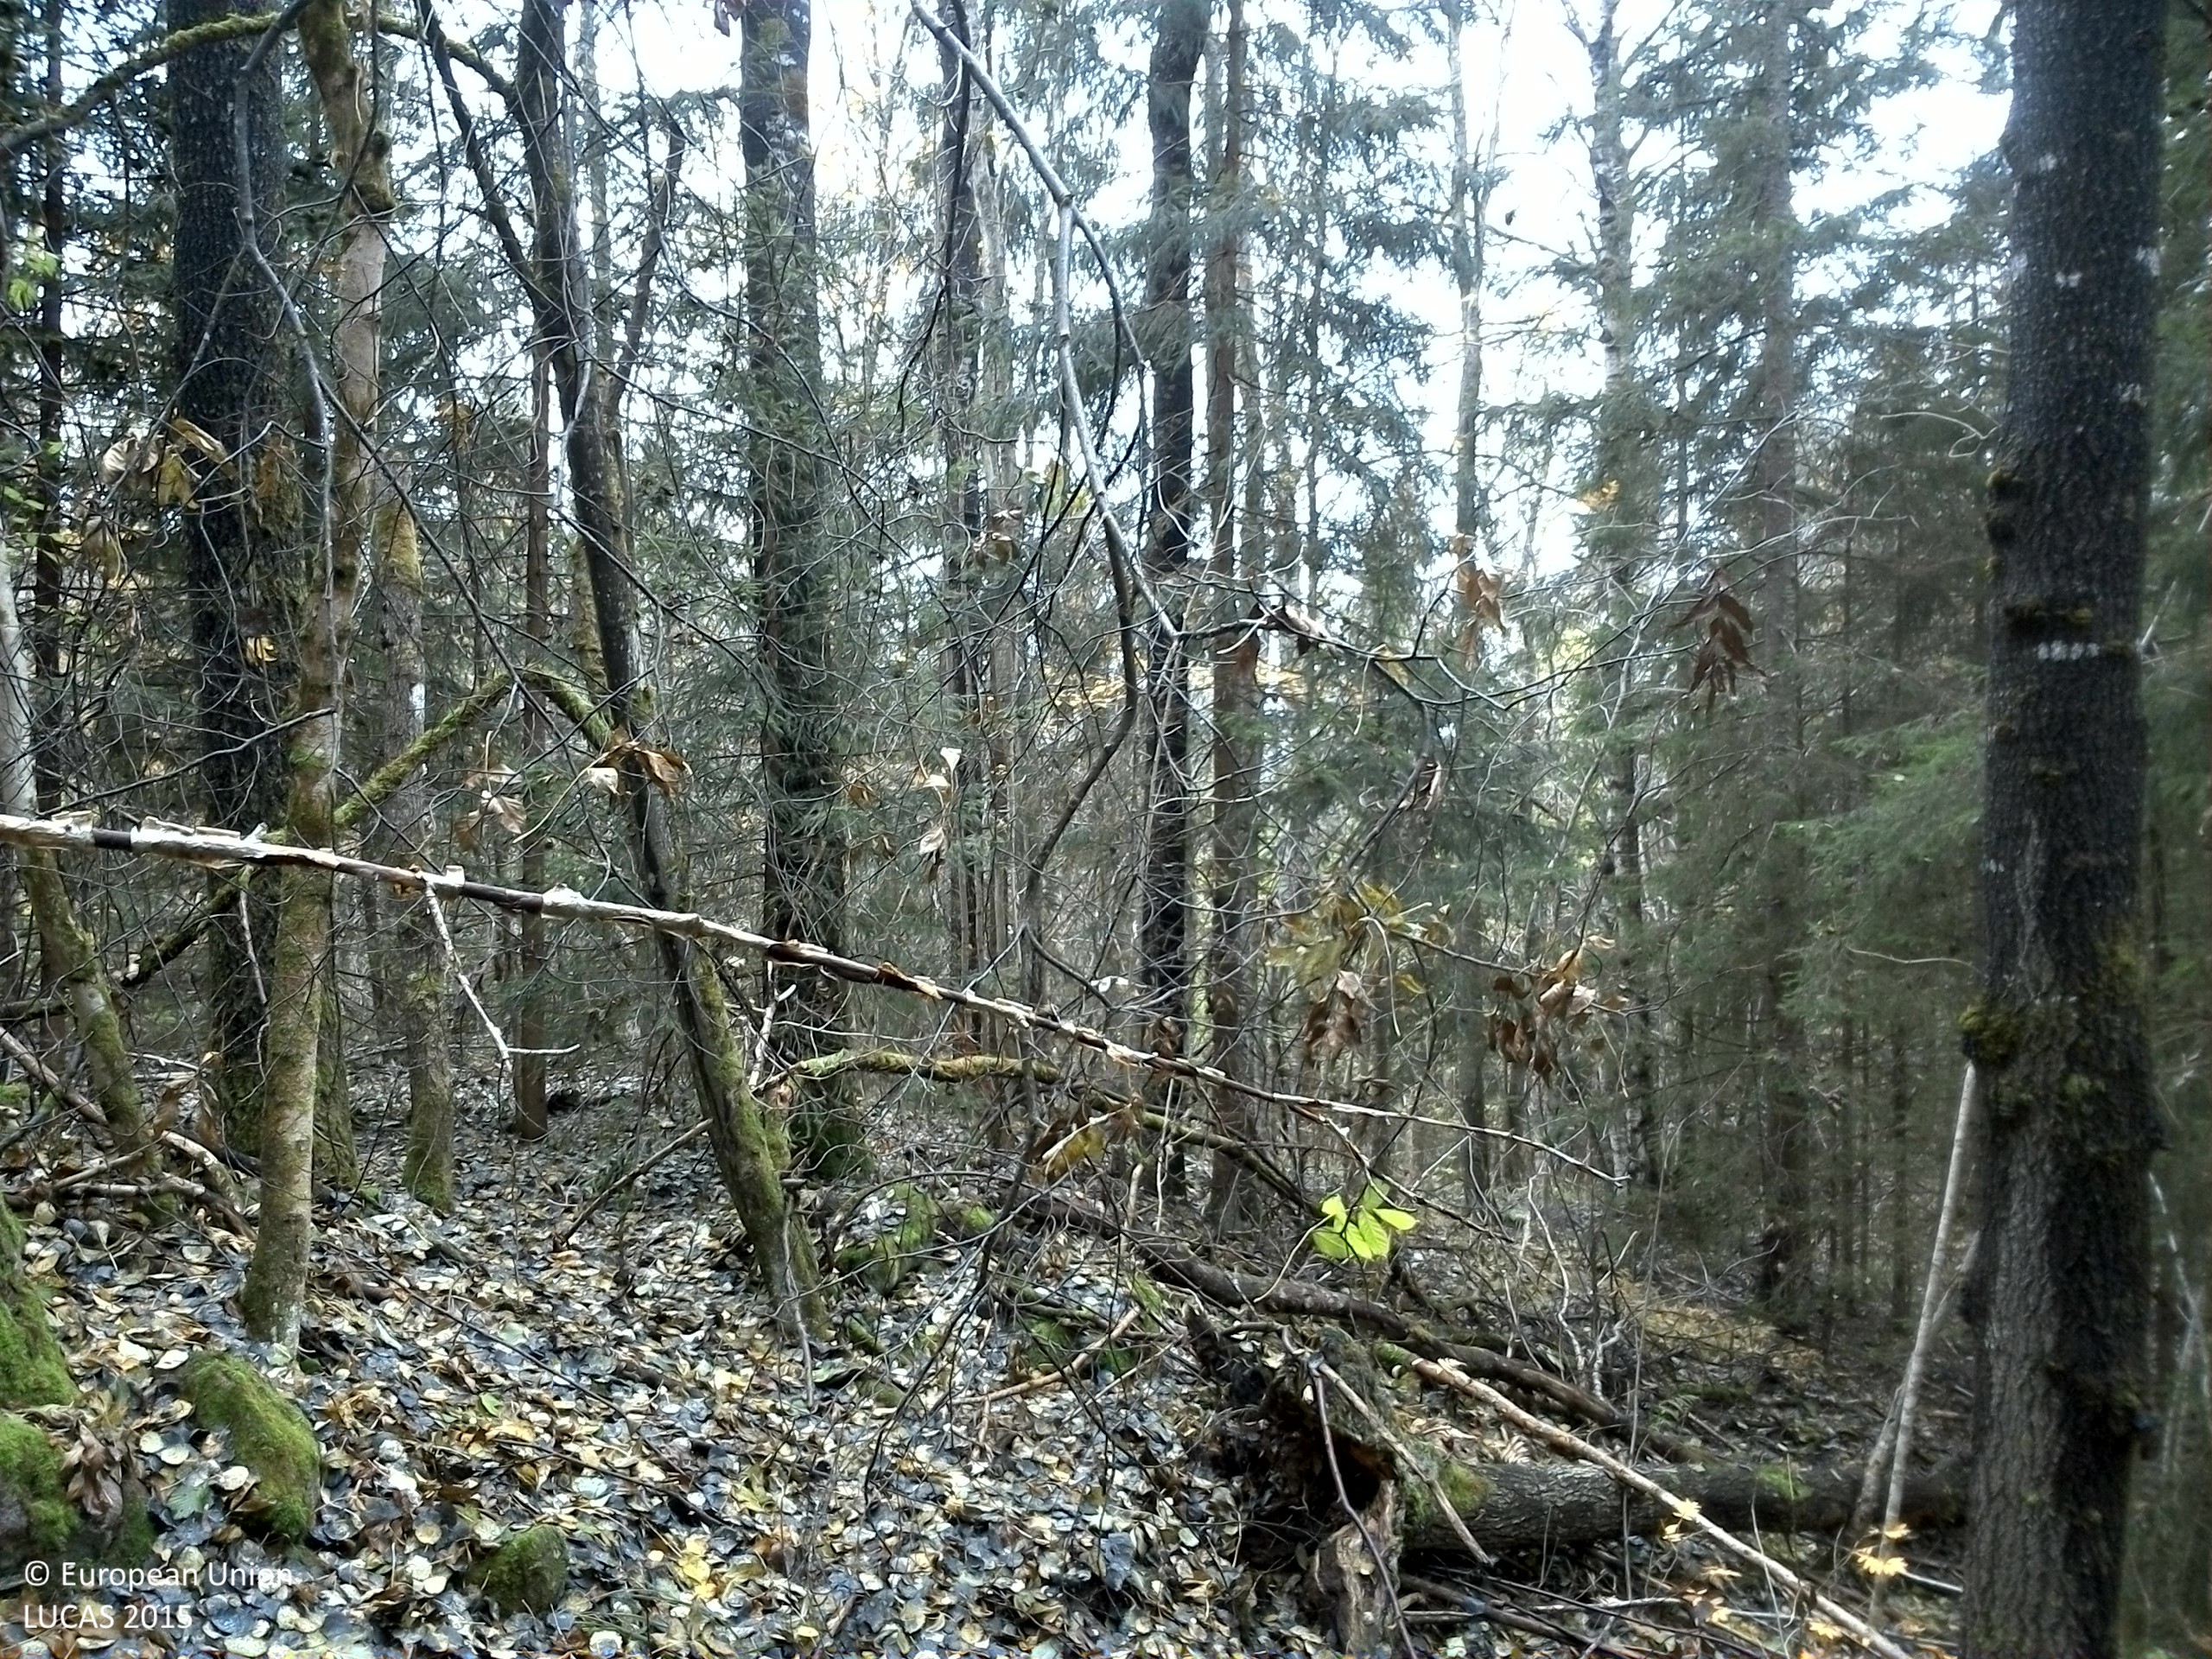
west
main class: Woodland
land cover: Spruce dominated mixed woodland
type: boreal forest
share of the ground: 50 - 75 %
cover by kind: coniferous forest trees 45 %, broadleaved forest trees 20 %, shrubs 15 %, herbaceous plants 10 %, lichens and mosses 10 %
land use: Forestry
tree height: > 5 m
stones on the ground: 10 - 25 %
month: October
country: SE
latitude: 59.7240
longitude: 15.2005
